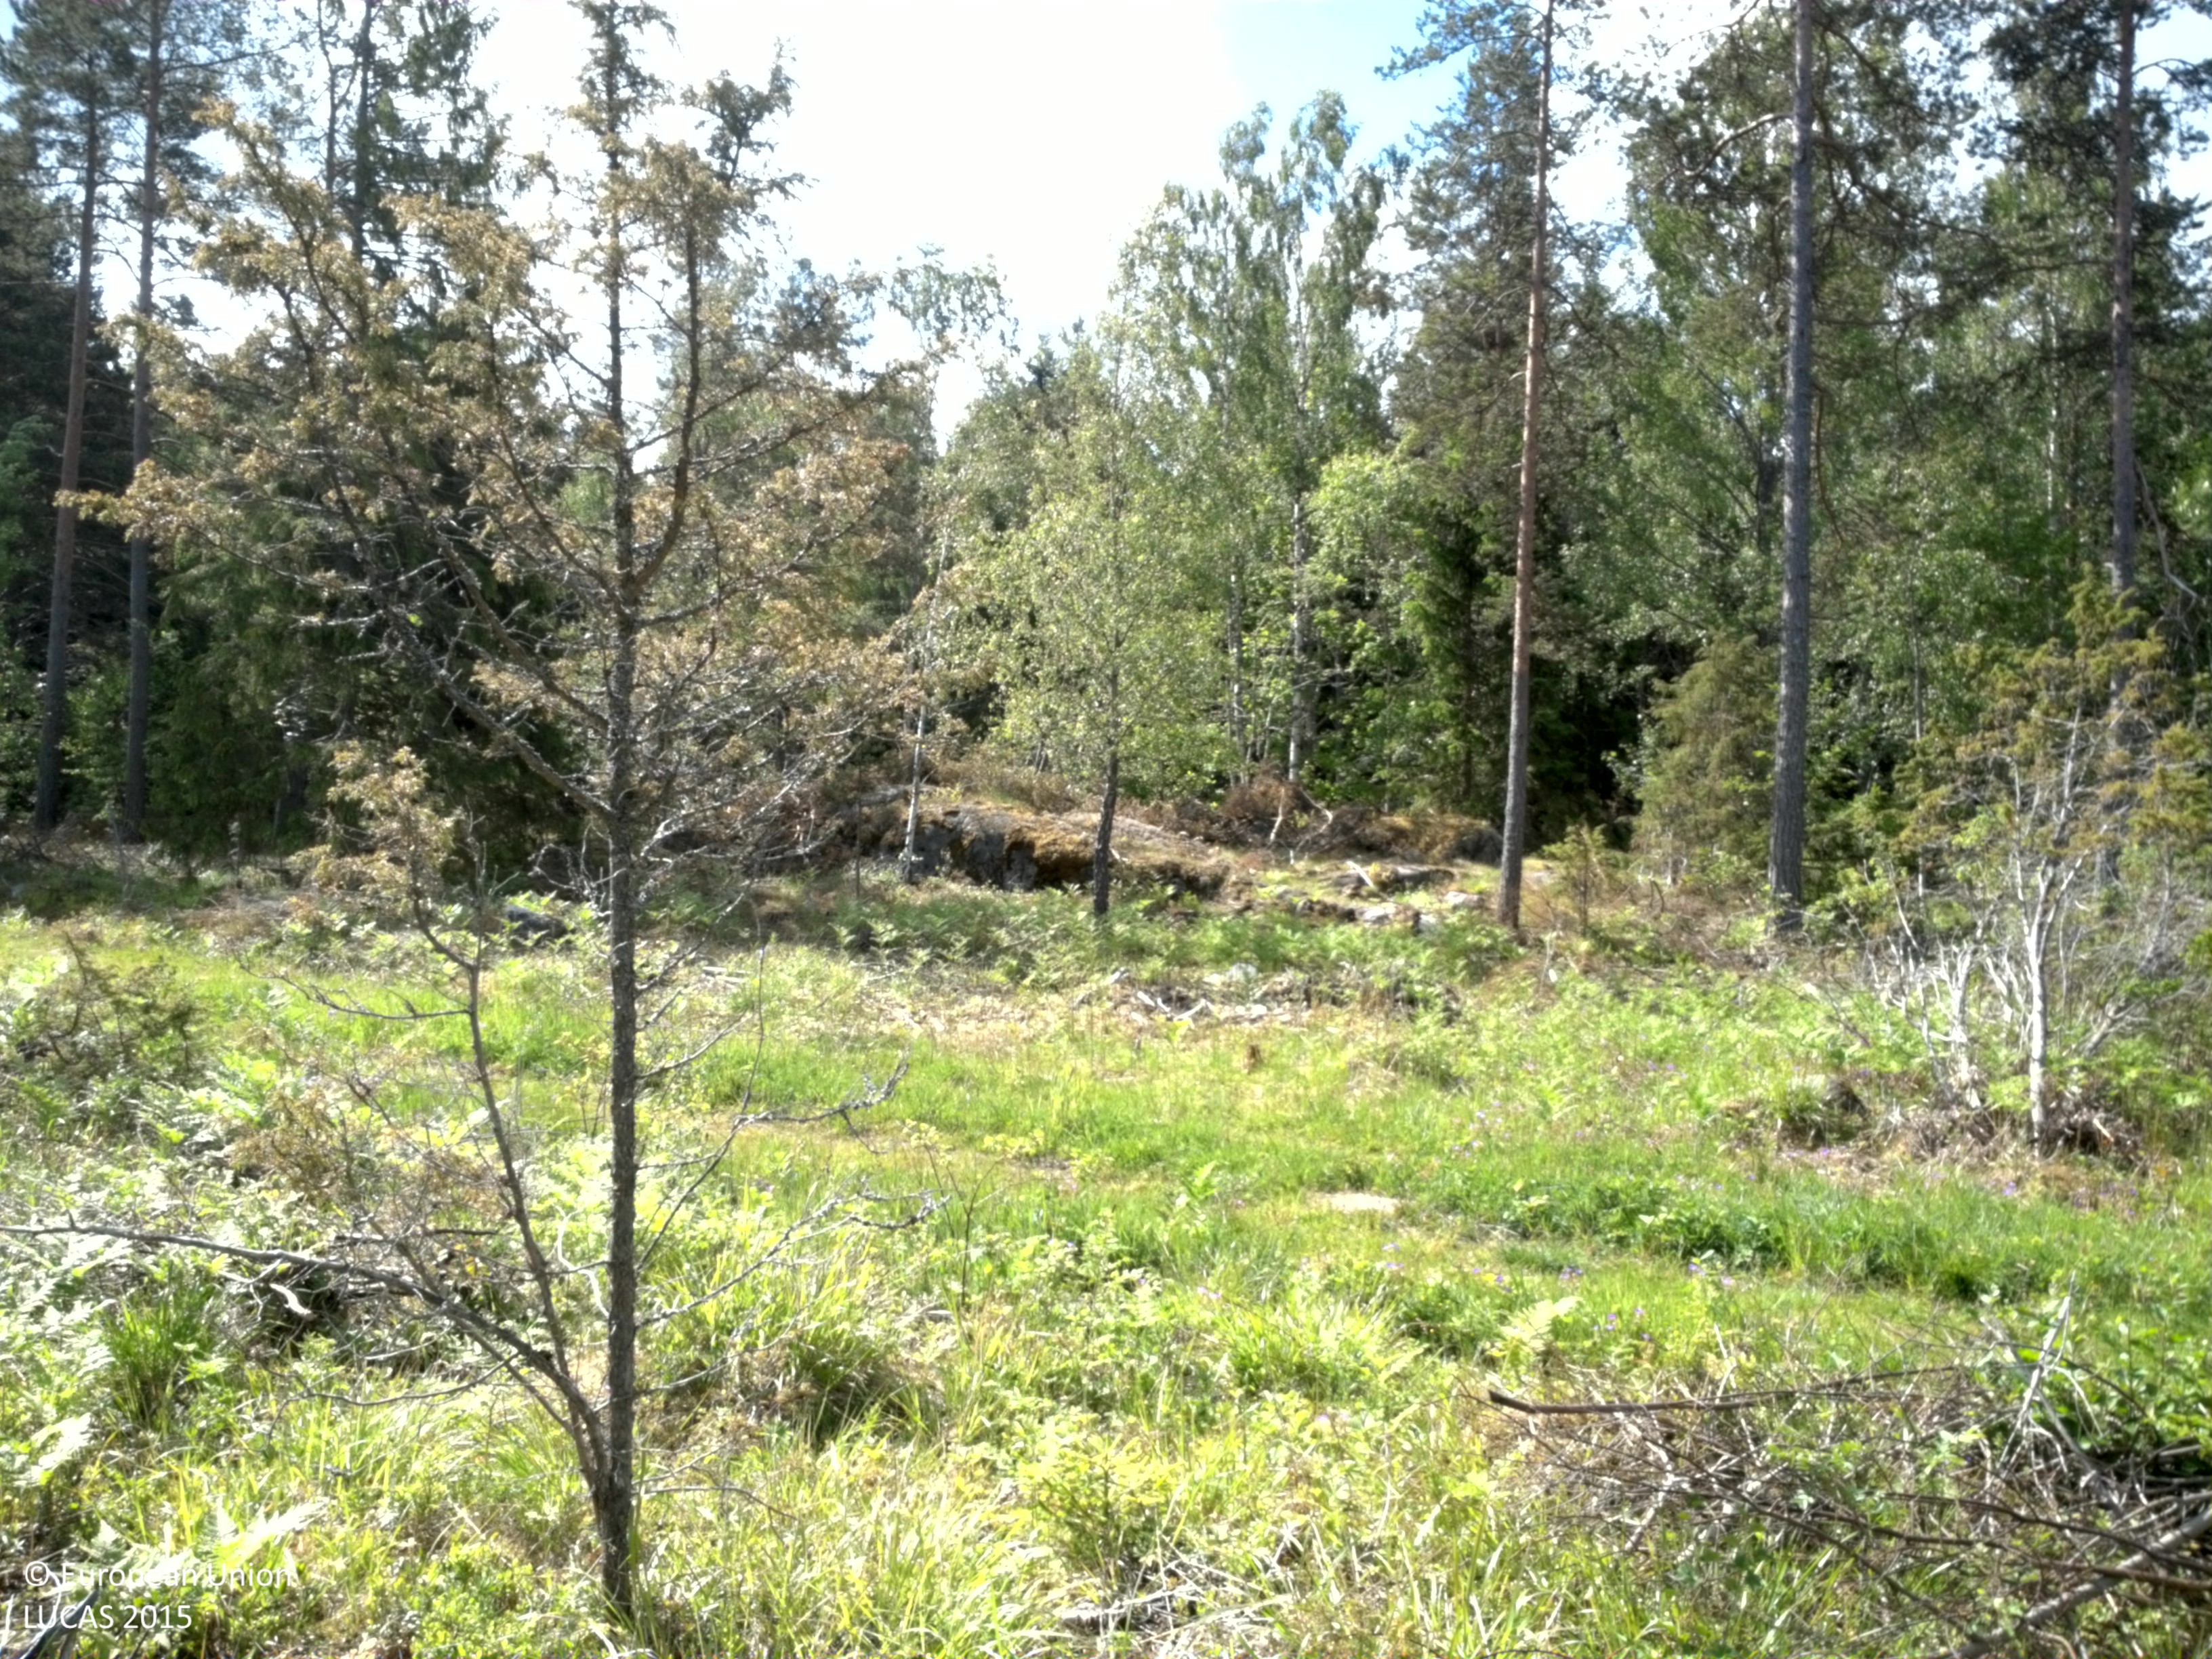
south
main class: Shrubland
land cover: Shrubland without tree cover
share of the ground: 10 - 25 %
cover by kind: herbaceous plants 65 %, shrubs 25 %, lichens and mosses 10 %
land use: Telecommunication
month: June
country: SE
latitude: 60.0560
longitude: 18.7094
